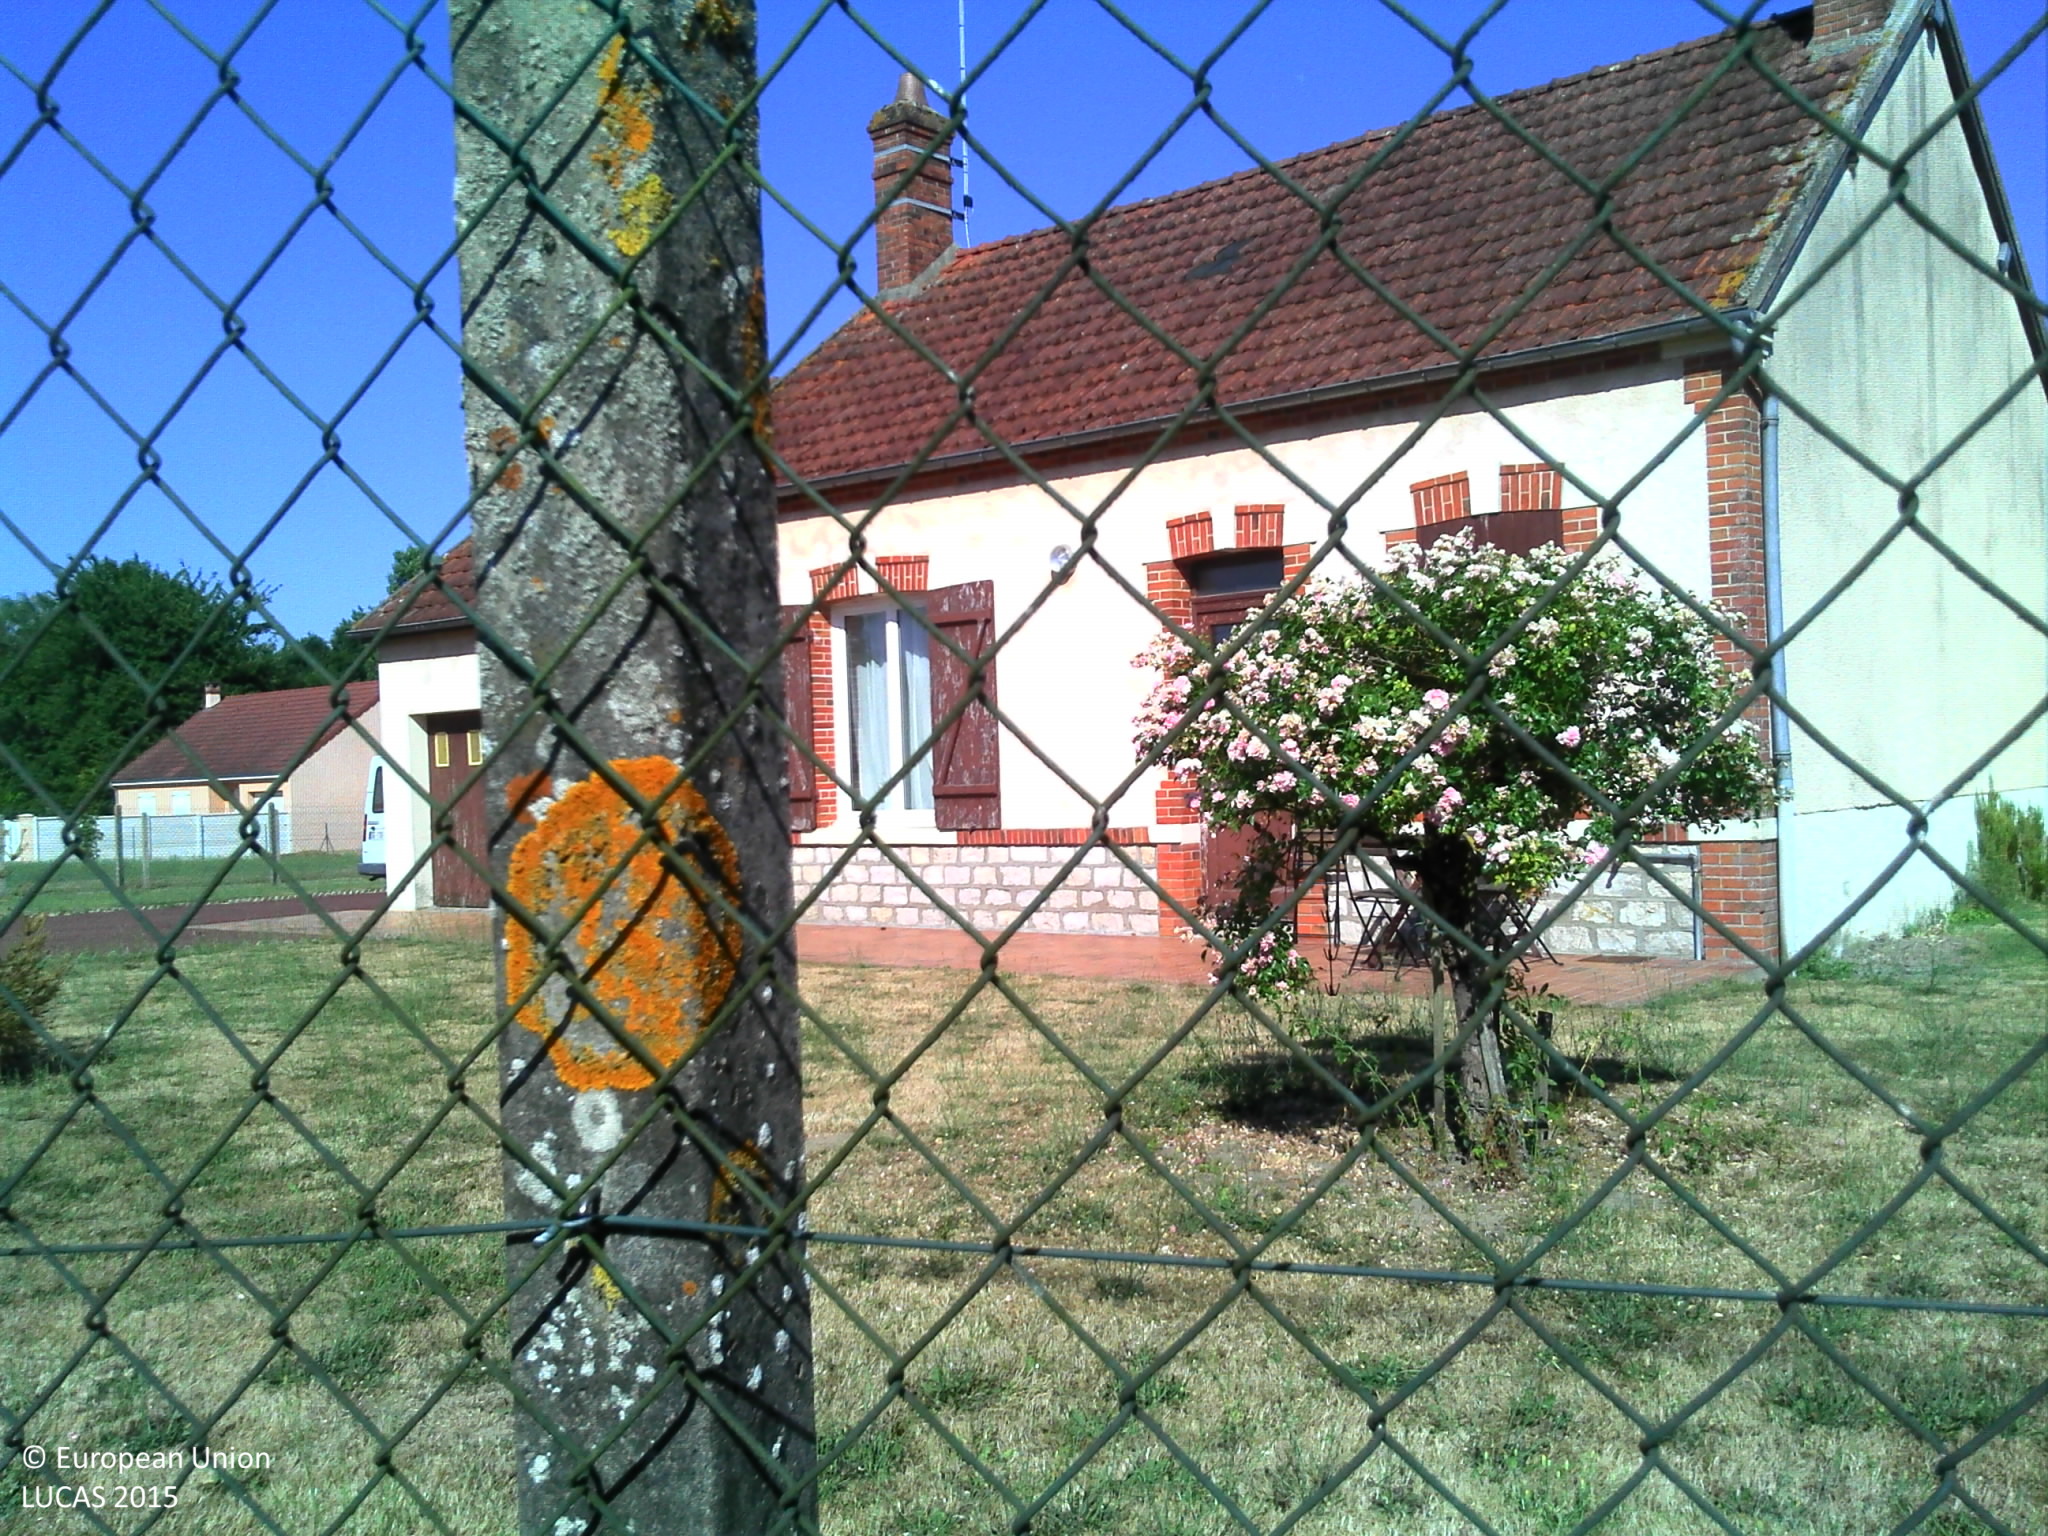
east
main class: Grassland
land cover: Grassland with sparse tree/shrub cover
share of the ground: > 75 %
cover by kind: herbaceous plants 95 %, coniferous forest trees 5 %
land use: Residential
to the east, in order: Grass margins; Fences; Grassland with sparse tree/shrub cover; Artificial constructions in urban areas; Broadleaved woodland
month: July
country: FR
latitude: 47.8965
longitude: 2.5137
